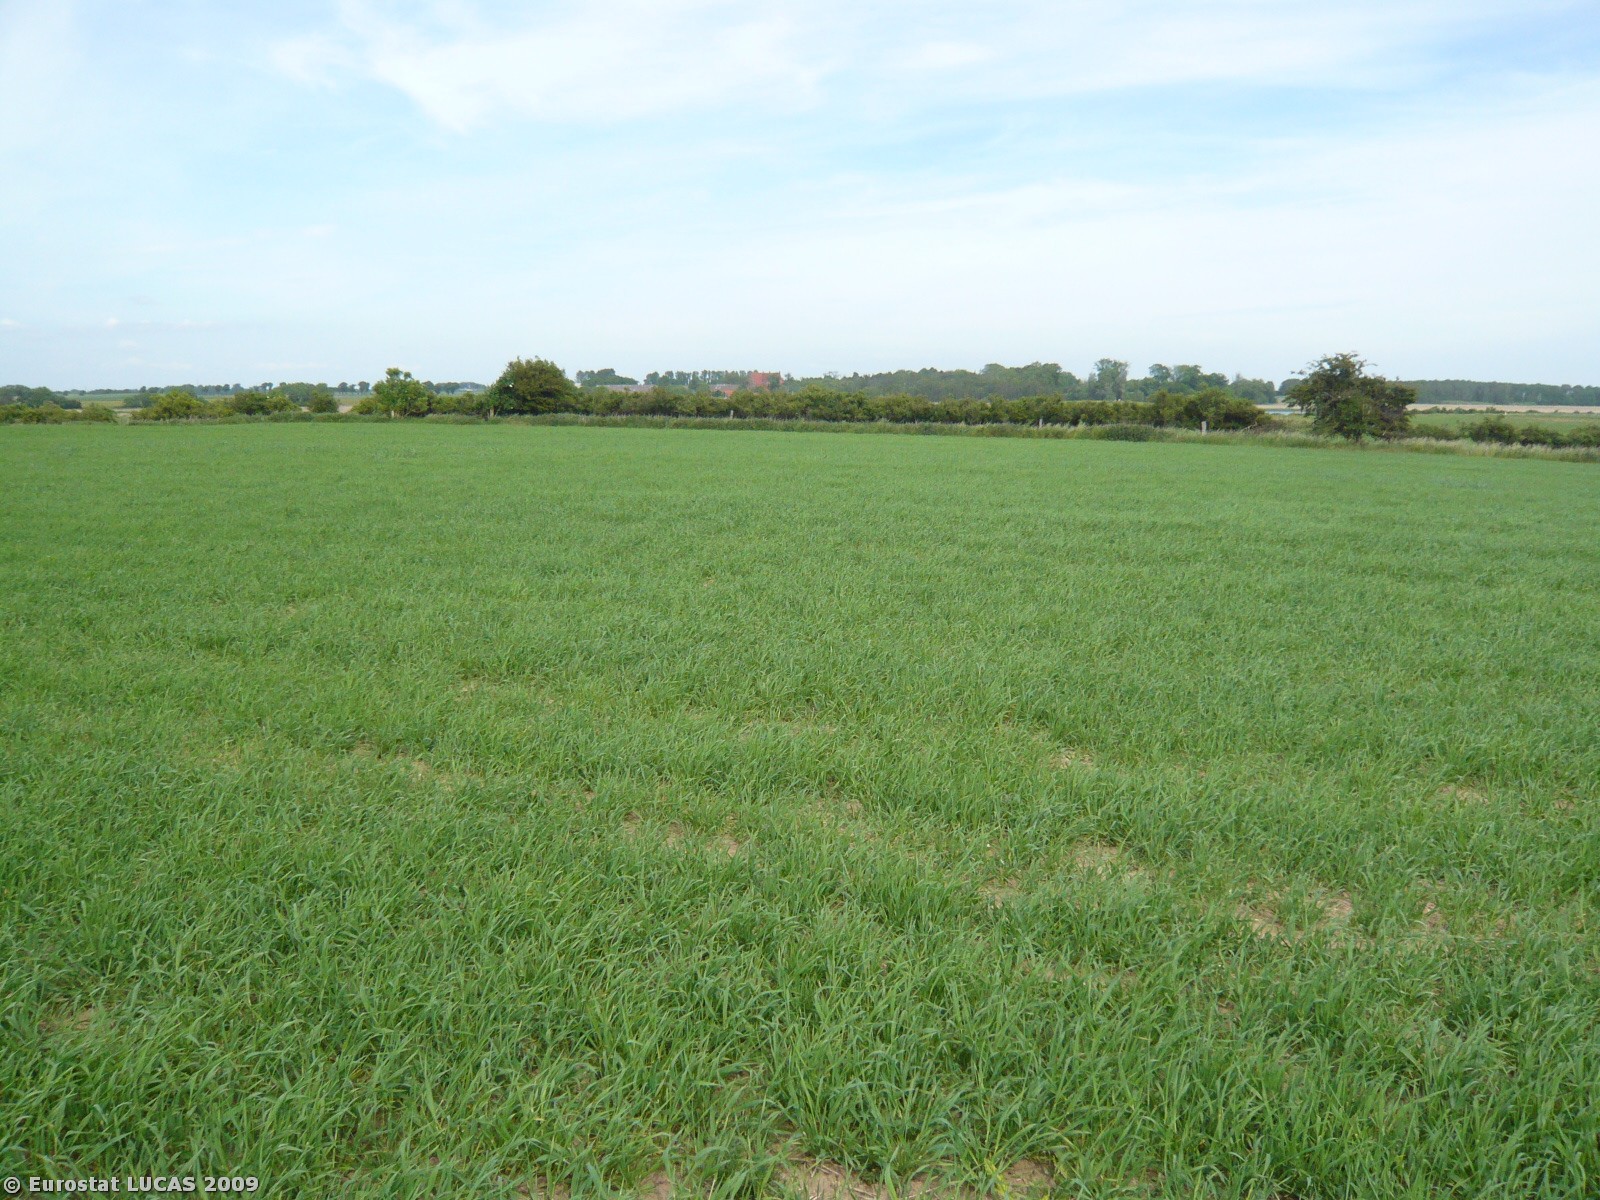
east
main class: Cropland
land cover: Barley
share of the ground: > 75 %
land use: Agriculture (excluding fallow land and kitchen gardens)
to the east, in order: Barley; Fences; Broadleaved woodland; Sugar beet
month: June
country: DK
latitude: 55.2287
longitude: 11.2725
